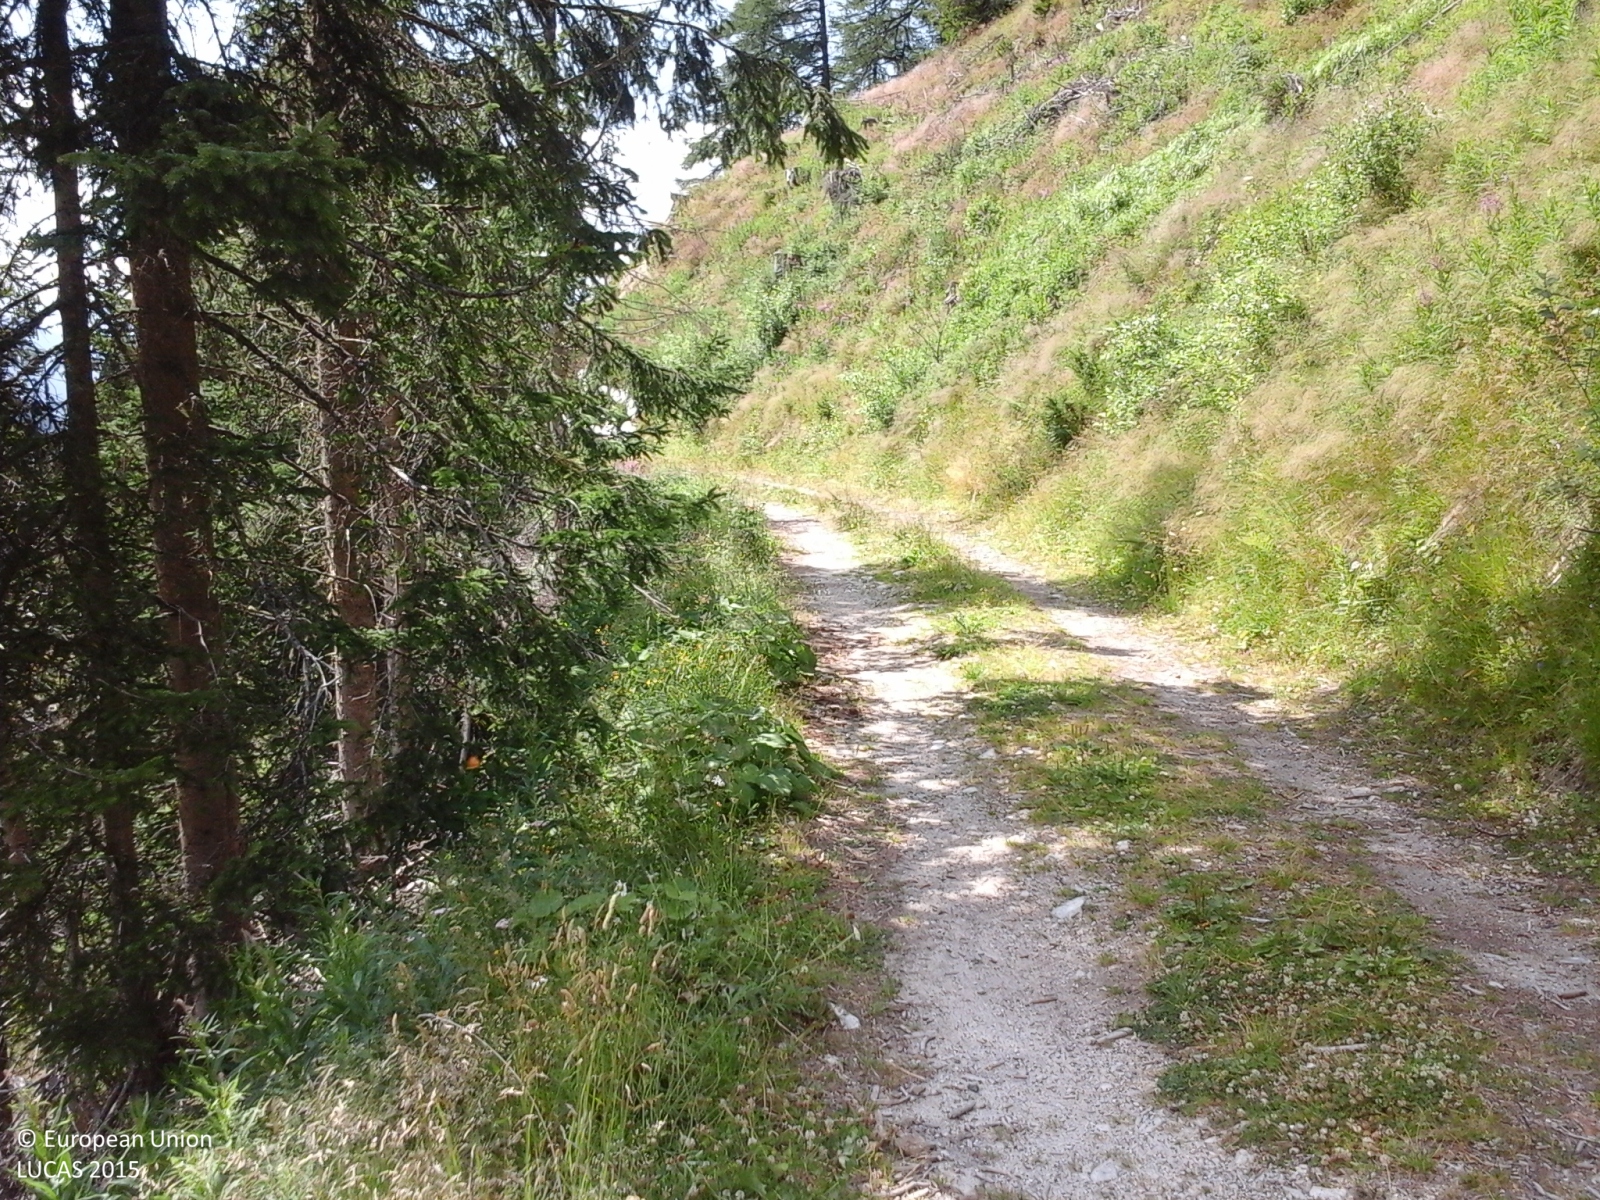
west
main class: Woodland
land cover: Spruce dominated coniferous woodland
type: alpine coniferous forest
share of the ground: > 75 %
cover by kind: coniferous forest trees 100 %
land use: Semi-natural and natural areas not in use
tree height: > 5 m
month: July
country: IT
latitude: 46.8438
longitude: 11.5850
